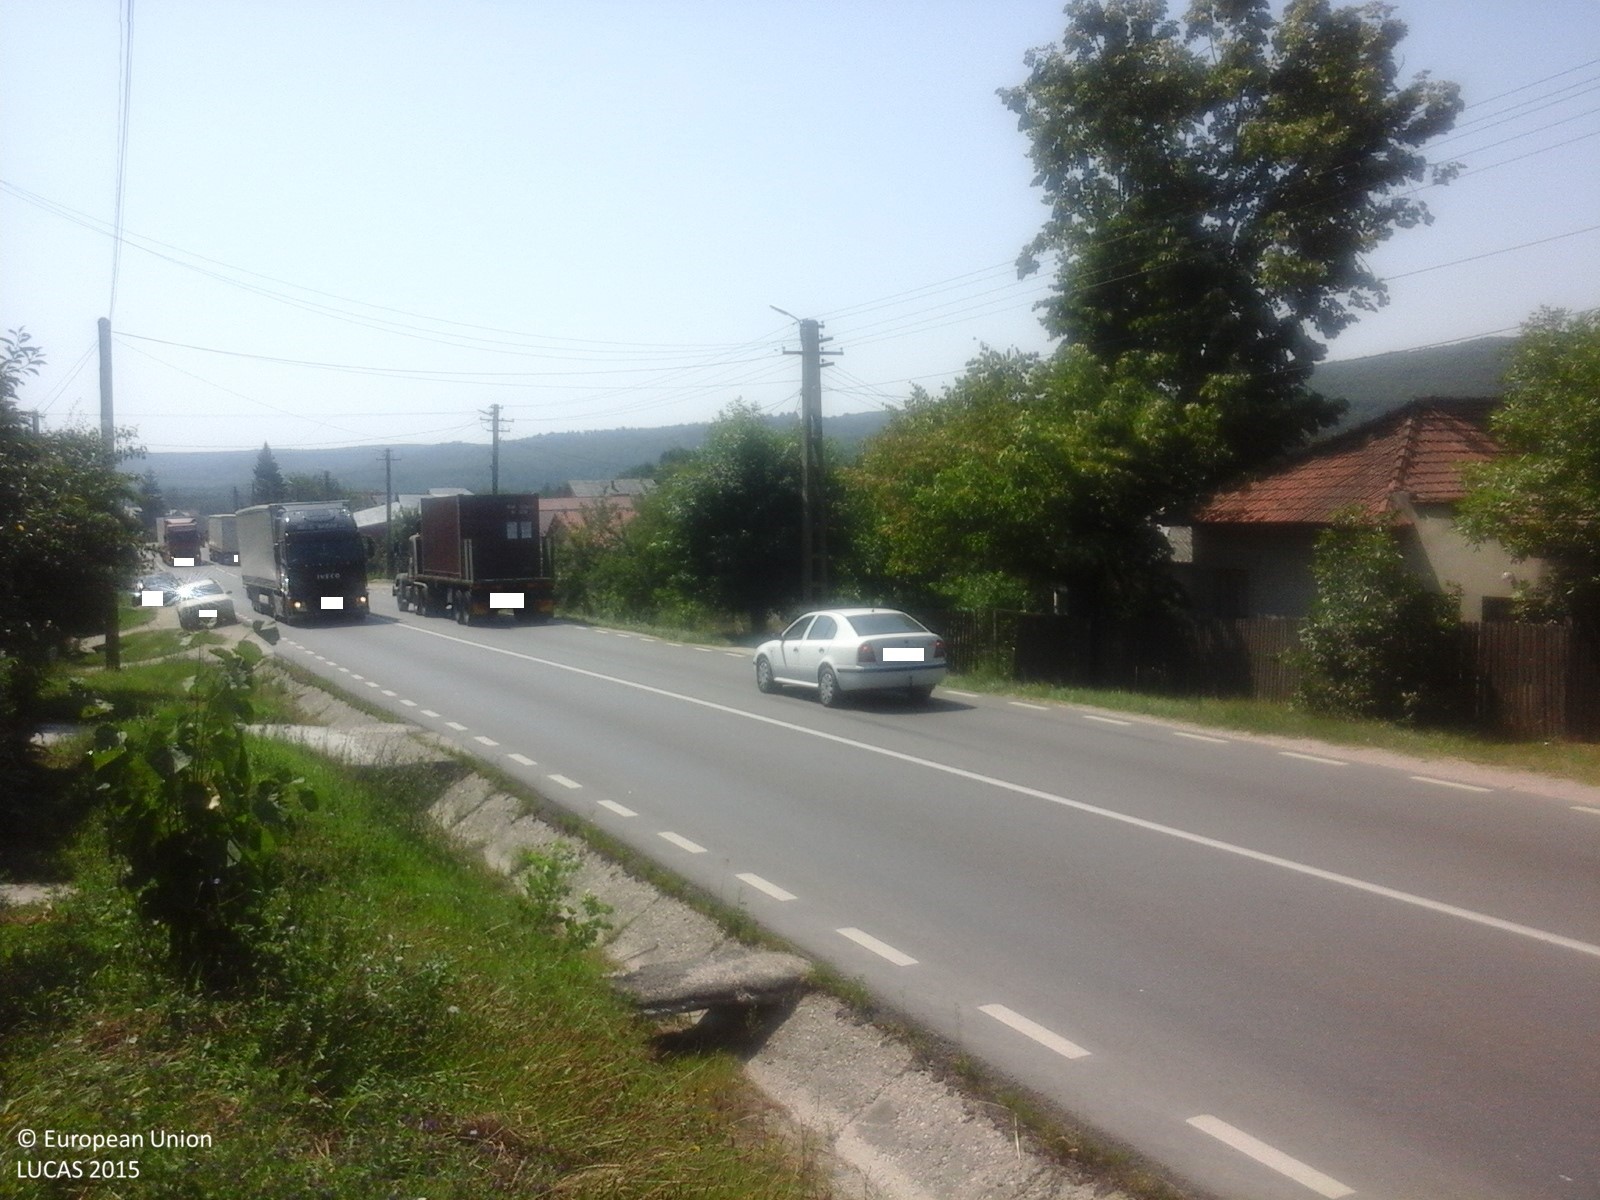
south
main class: Grassland
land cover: Grassland without tree/shrub cover
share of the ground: > 75 %
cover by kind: herbaceous plants 100 %
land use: Agriculture (excluding fallow land and kitchen gardens)
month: July
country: RO
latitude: 44.9033
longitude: 24.7321
